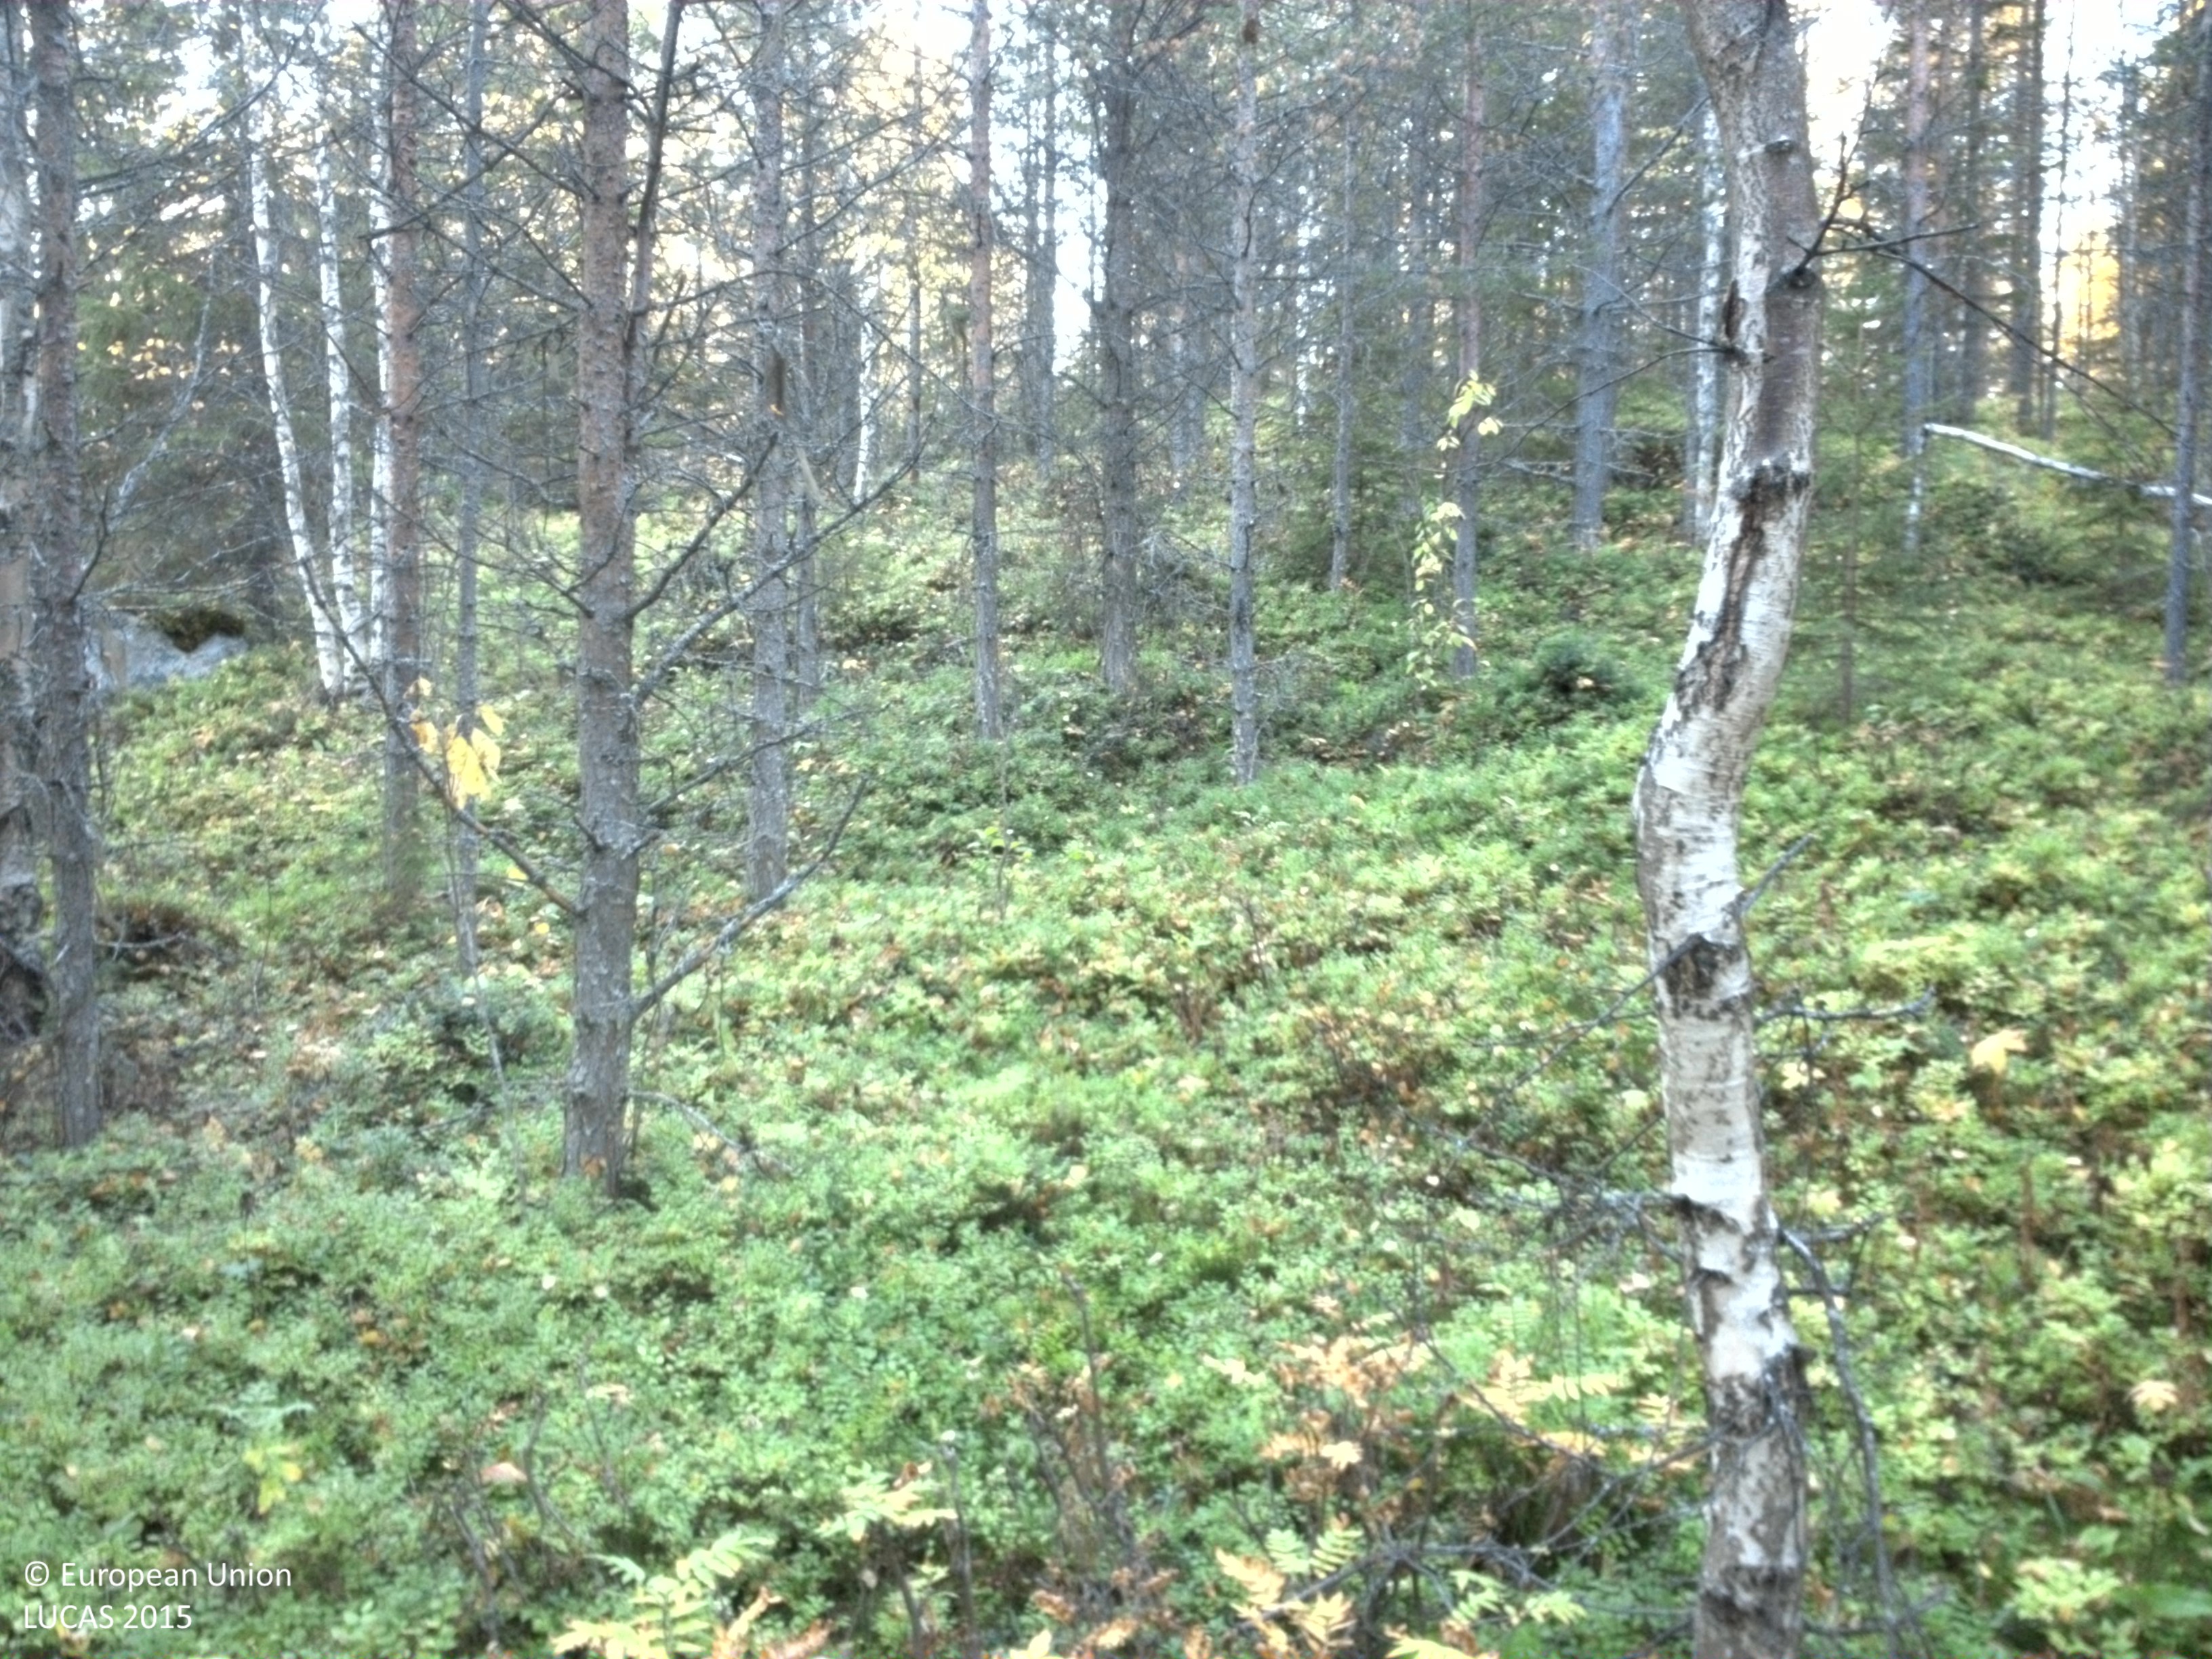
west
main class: Woodland
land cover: Pine dominated coniferous woodland
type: boreal forest
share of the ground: 50 - 75 %
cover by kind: coniferous forest trees 45 %, shrubs 35 %, broadleaved forest trees 10 %, herbaceous plants 10 %
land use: Forestry
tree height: > 5 m
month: September
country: SE
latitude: 64.9342
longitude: 17.7702
